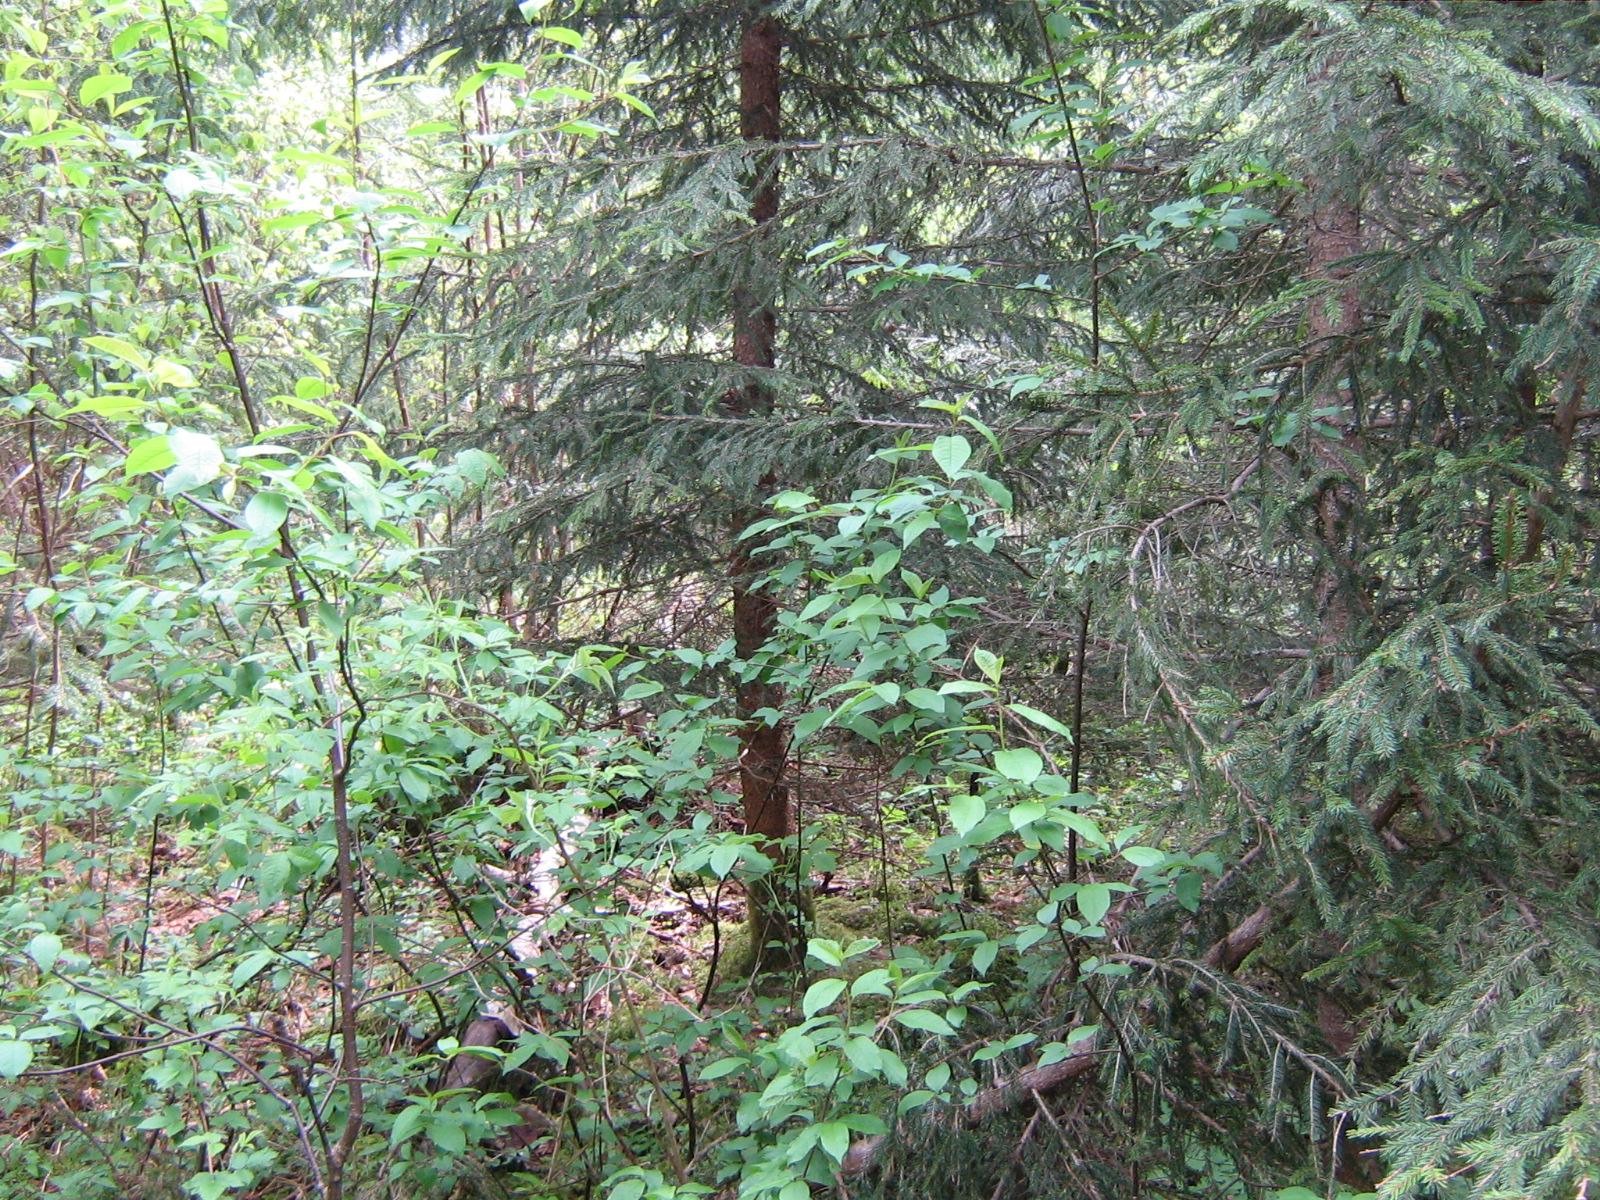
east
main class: Woodland
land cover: Spruce dominated mixed woodland
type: hemiboreal forest and nemoral coniferous forest and mixed broadleaved-coniferous forest
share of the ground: > 75 %
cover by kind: coniferous forest trees 75 %, broadleaved forest trees 25 %
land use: Forestry
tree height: > 5 m
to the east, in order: Spruce dominated mixed woodland; Inland marshes; Spruce dominated mixed woodland; Broadleaved woodland
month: May
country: LV
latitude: 57.2161
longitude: 25.5337
